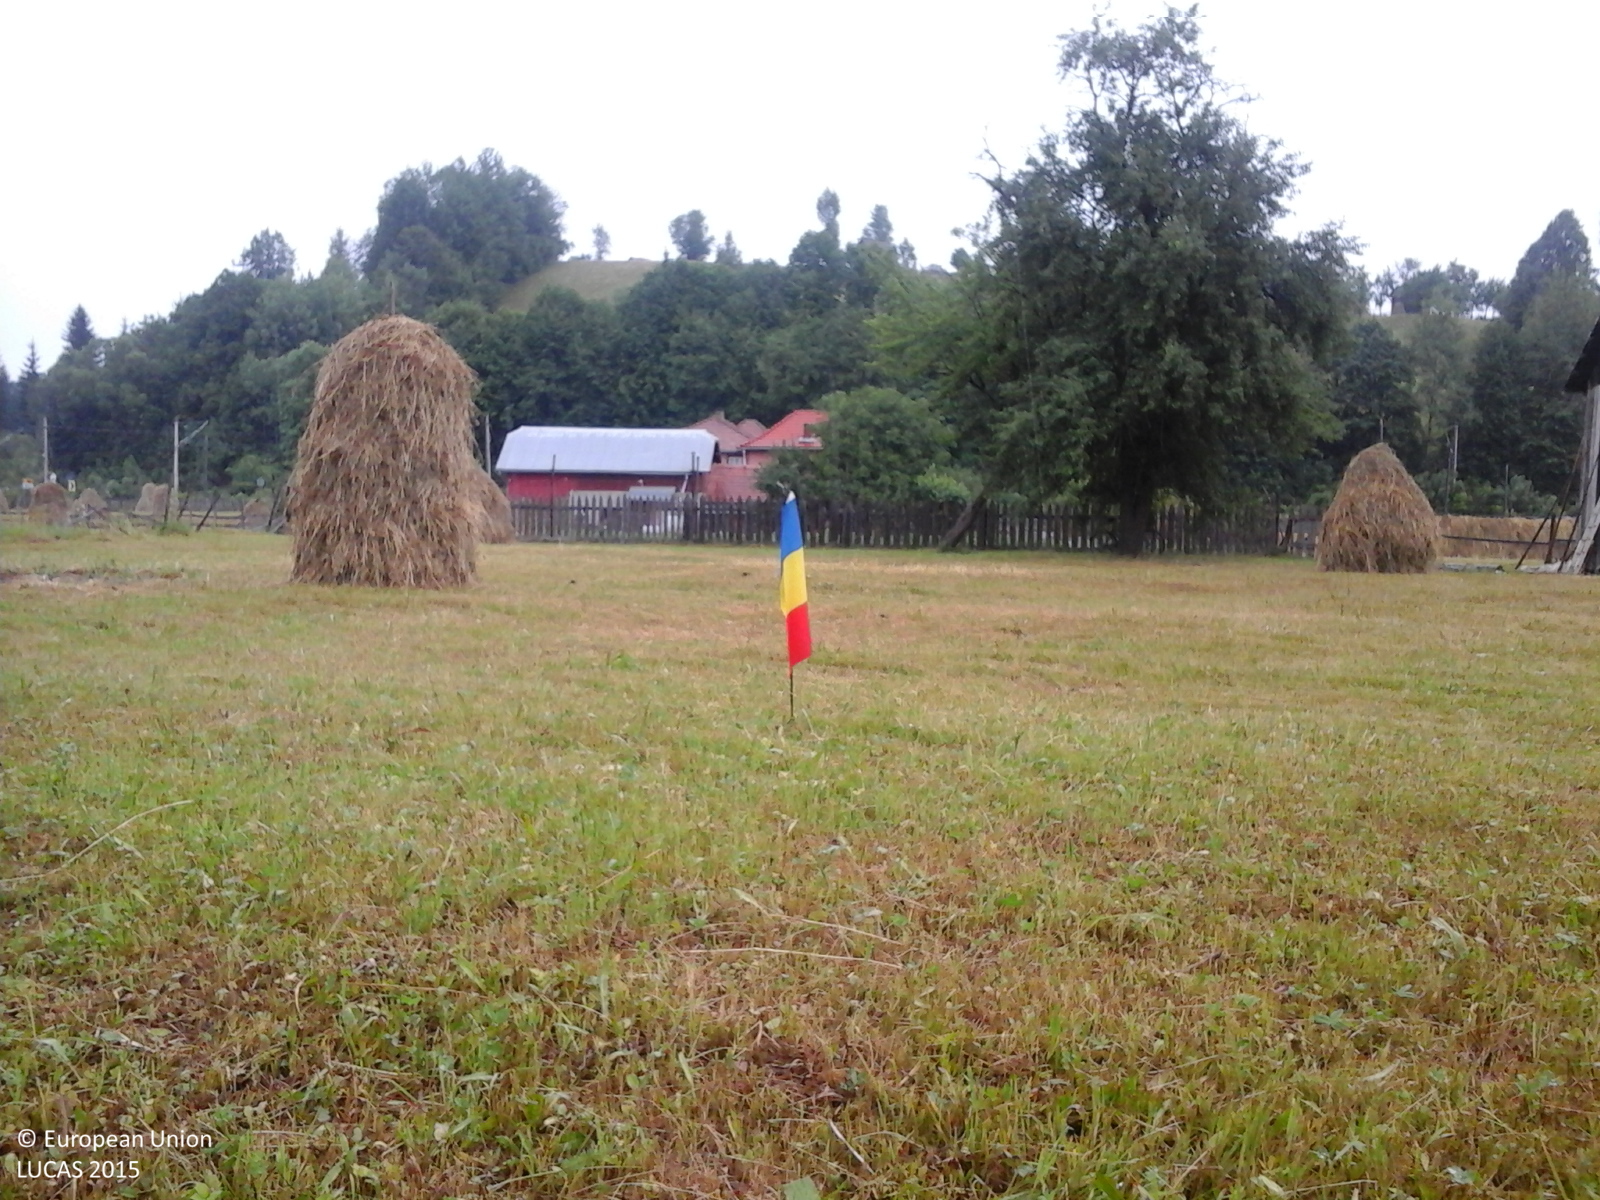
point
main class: Cropland
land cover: Other leguminous and mixtures for fodder
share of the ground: > 75 %
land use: Agriculture (excluding fallow land and kitchen gardens)
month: June
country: RO
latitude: 47.5603
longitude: 25.7386
